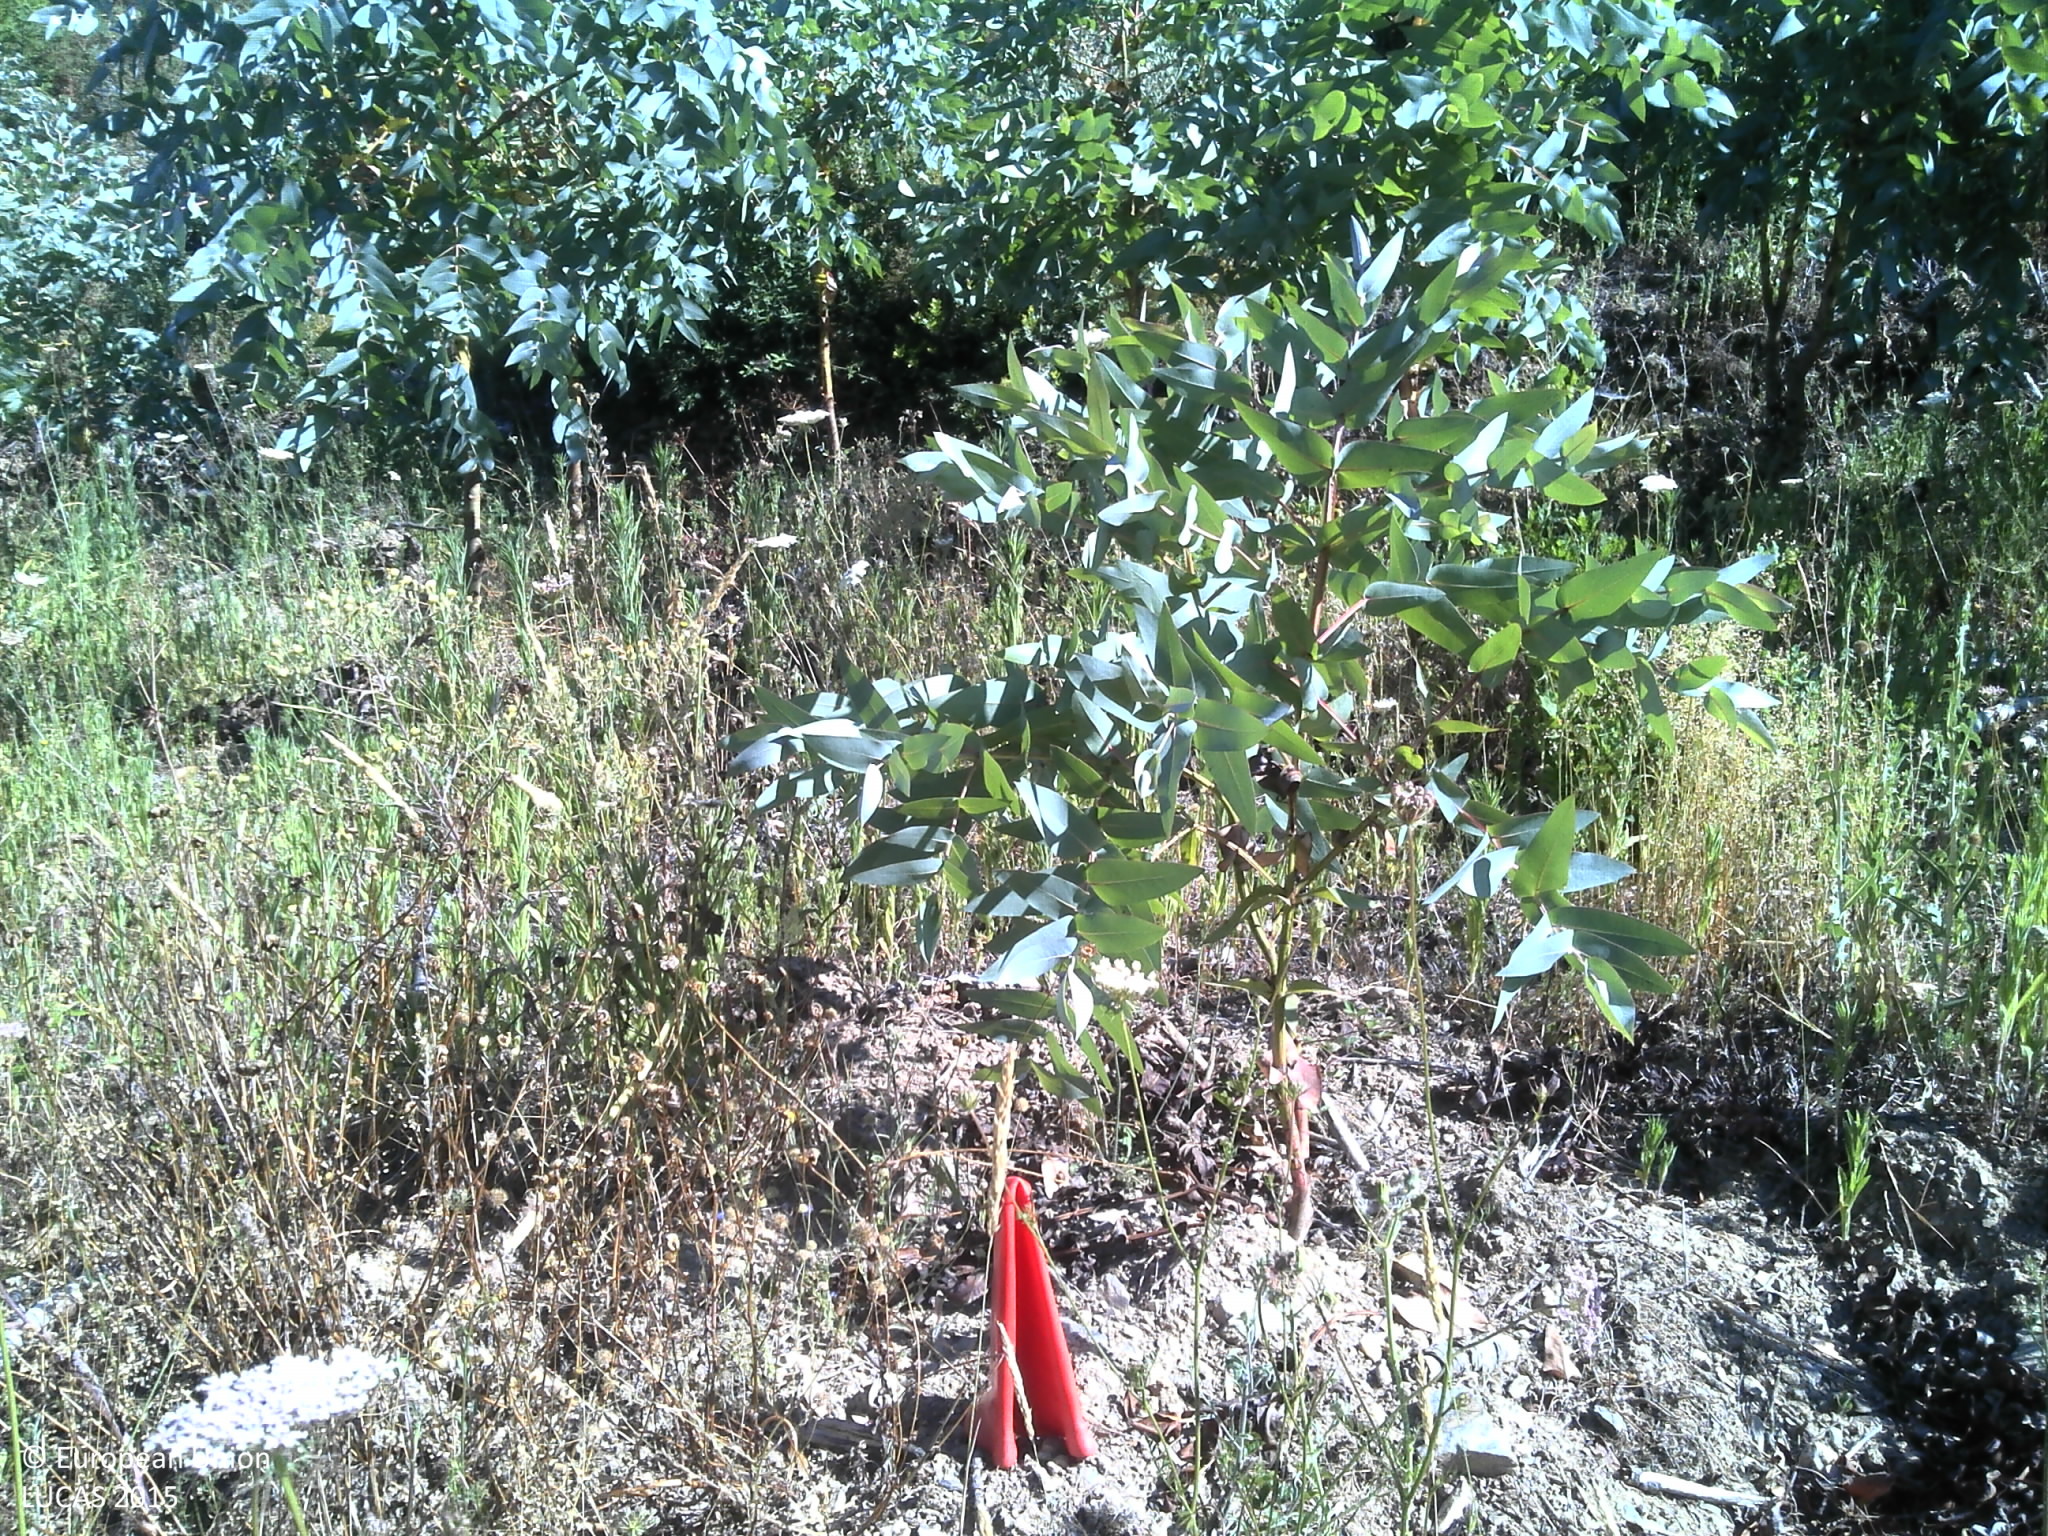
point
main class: Woodland
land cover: Broadleaved woodland
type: exotic forest
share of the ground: 10 - 25 %
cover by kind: unconsolidated bare surface 50 %, broadleaved forest trees 25 %, shrubs 15 %, herbaceous plants 10 %
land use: Forestry
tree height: < 5 m
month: July
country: PT
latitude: 40.2285
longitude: -8.1154
